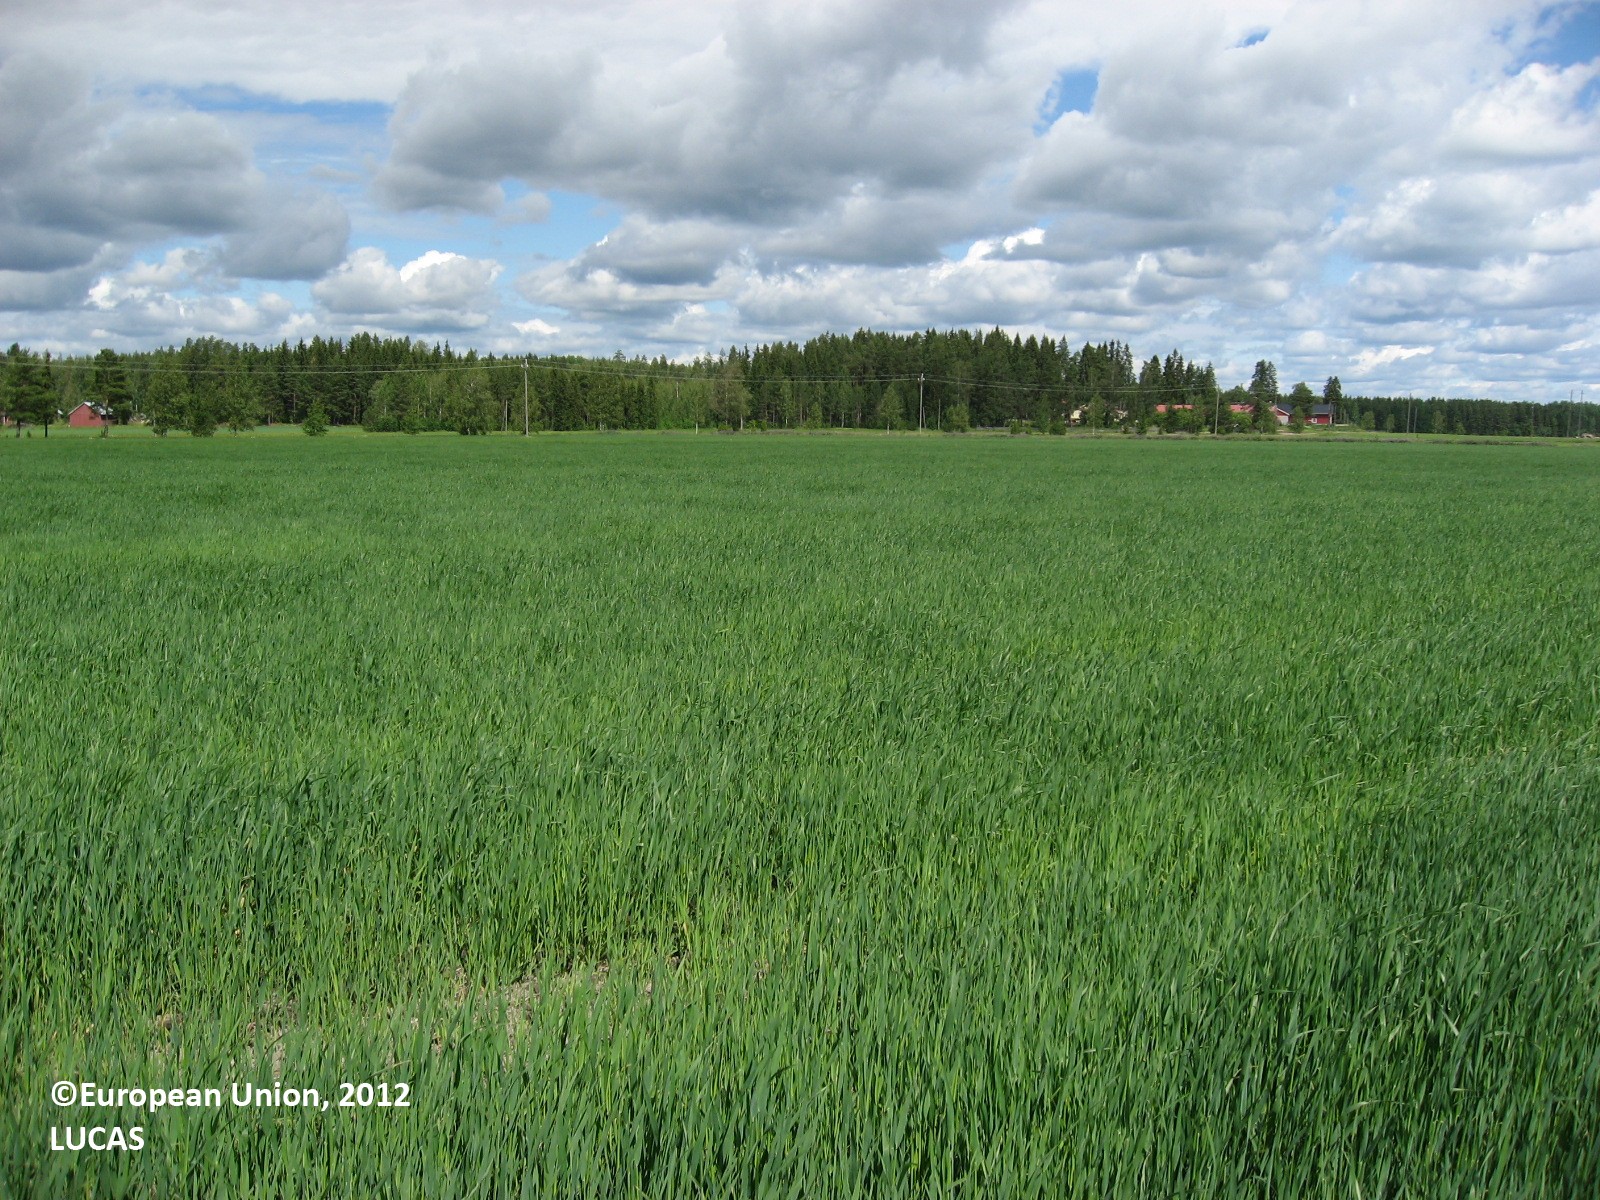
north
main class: Cropland
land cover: Oats
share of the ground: 50 - 75 %
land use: Agriculture (excluding fallow land and kitchen gardens)
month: June
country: FI
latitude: 60.7275
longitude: 26.5273
